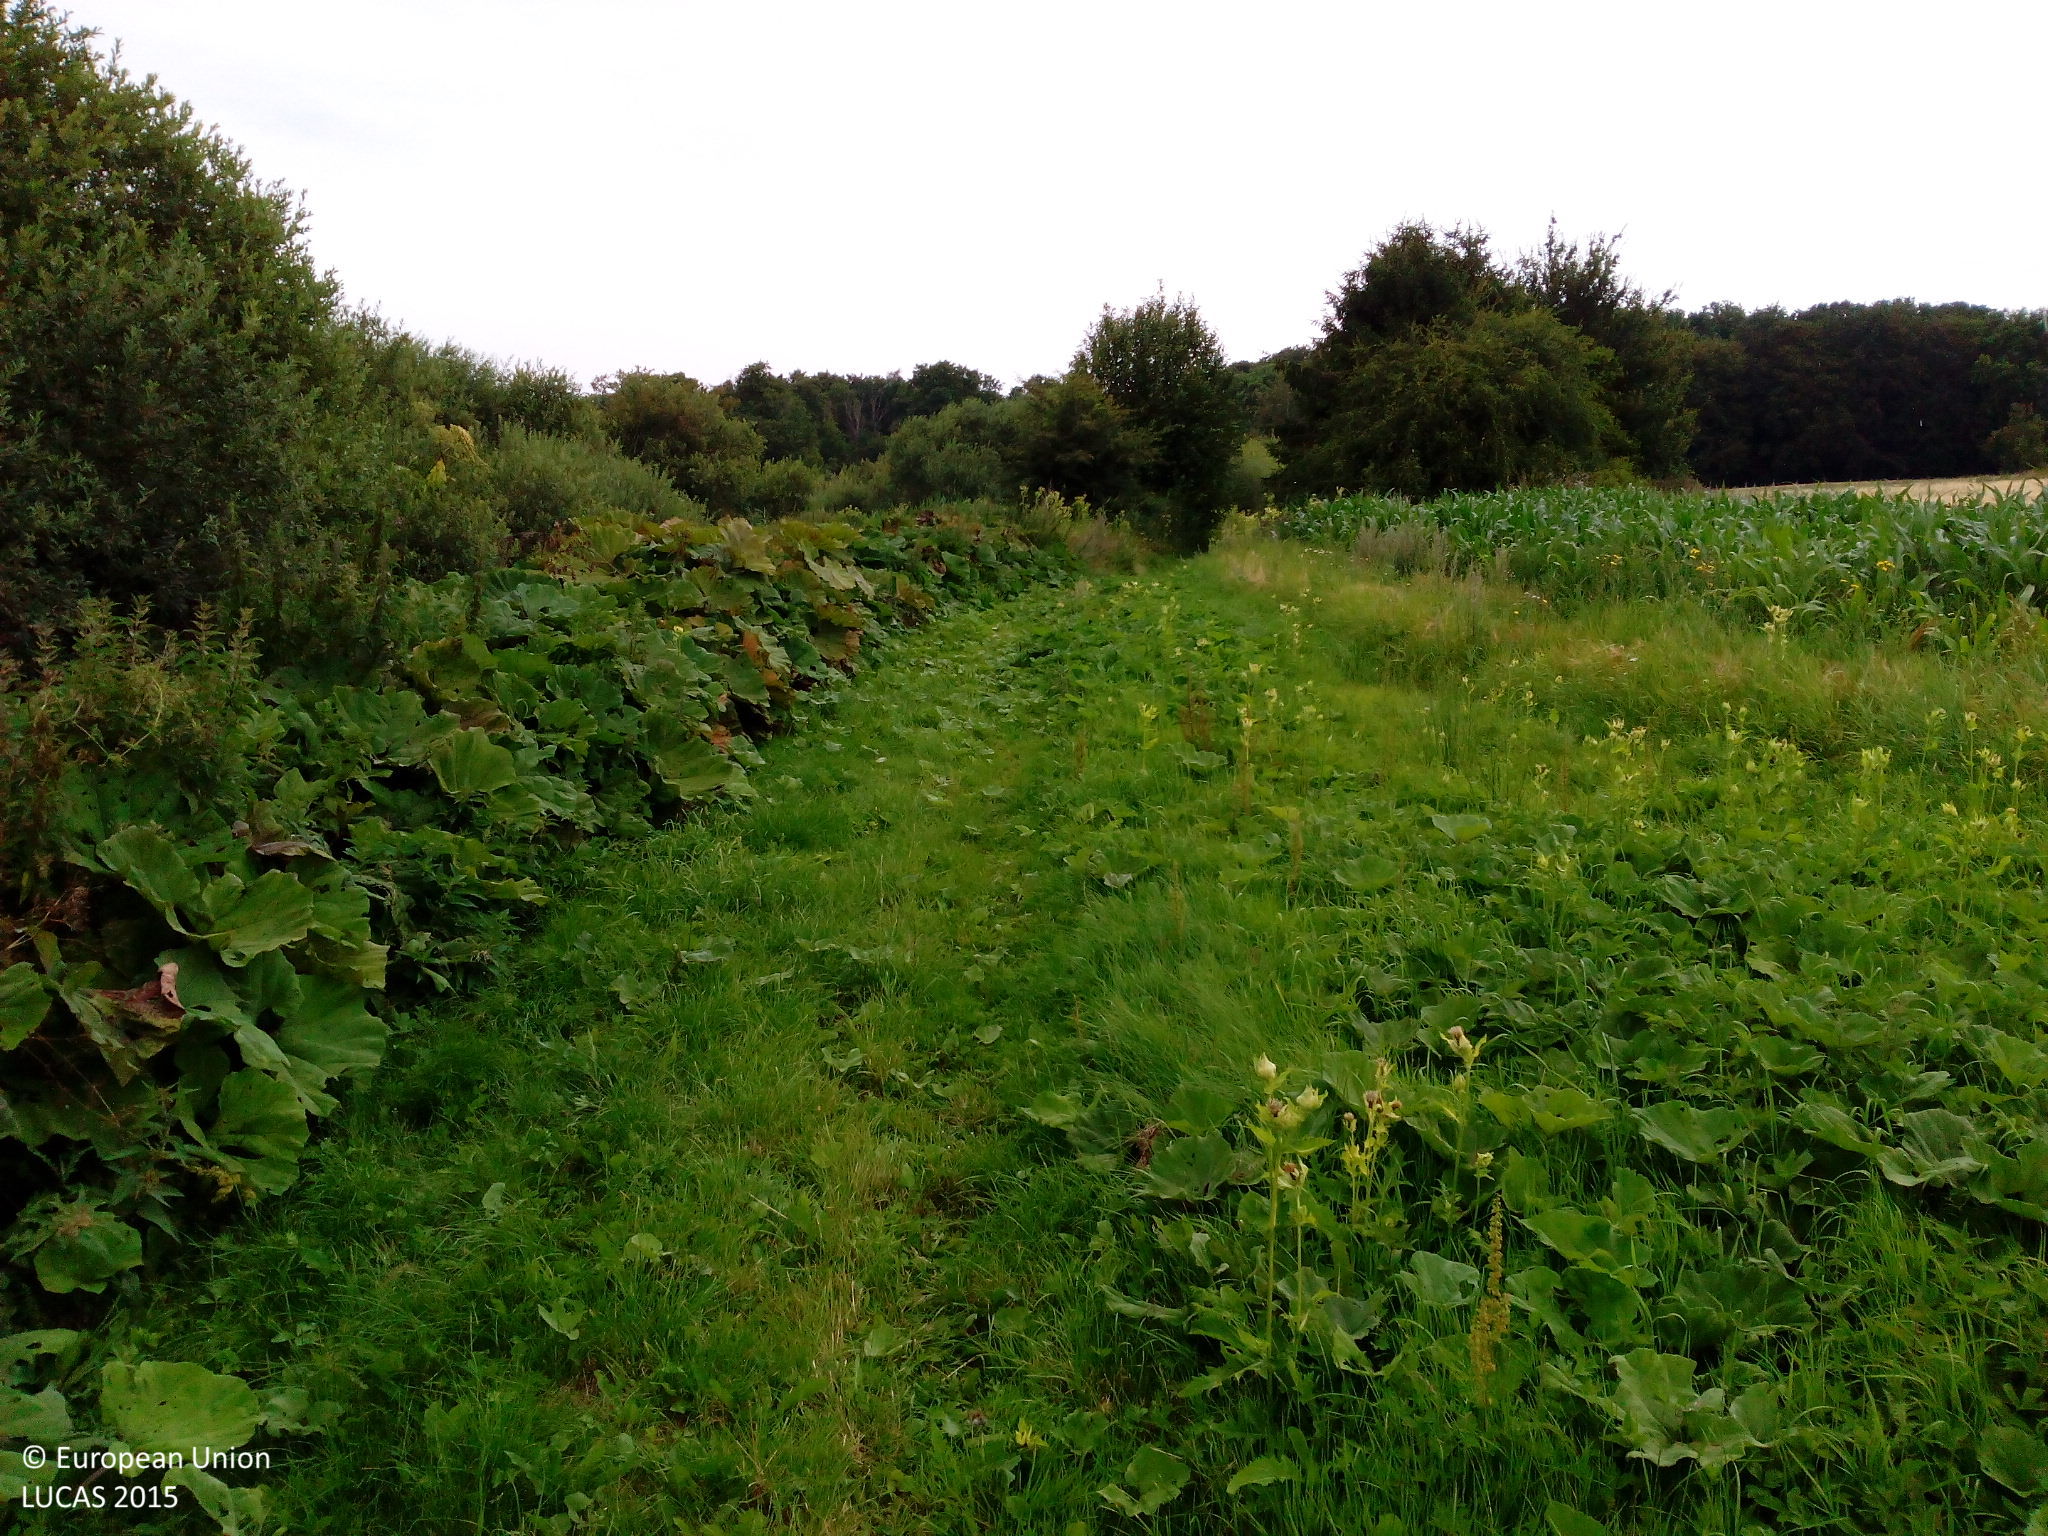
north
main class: Grassland
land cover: Grassland without tree/shrub cover
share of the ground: > 75 %
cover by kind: herbaceous plants 100 %
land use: Semi-natural and natural areas not in use
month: August
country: DK
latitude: 55.5252
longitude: 11.9785
